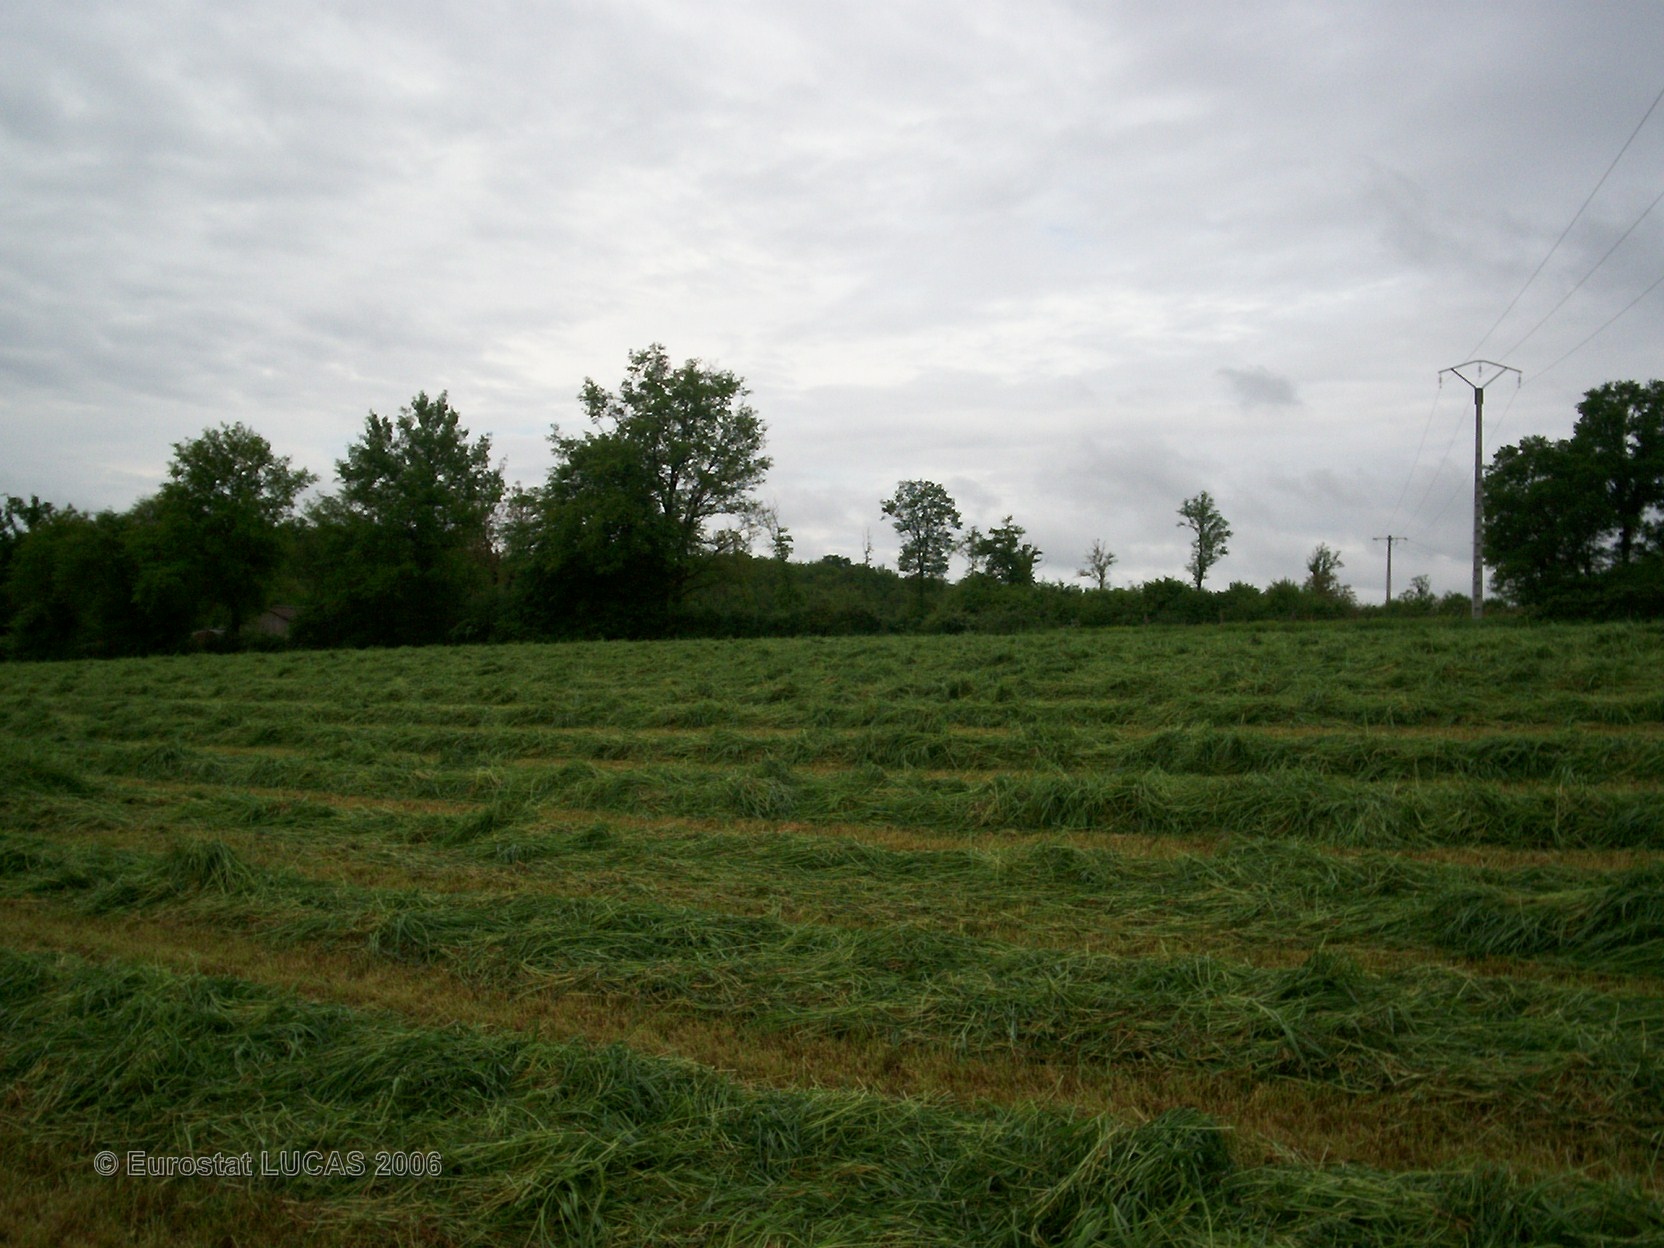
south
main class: Grassland
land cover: Grassland without tree/shrub cover
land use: Agriculture (excluding fallow land and kitchen gardens)
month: May
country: FR
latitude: 46.0531
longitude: 0.4846
